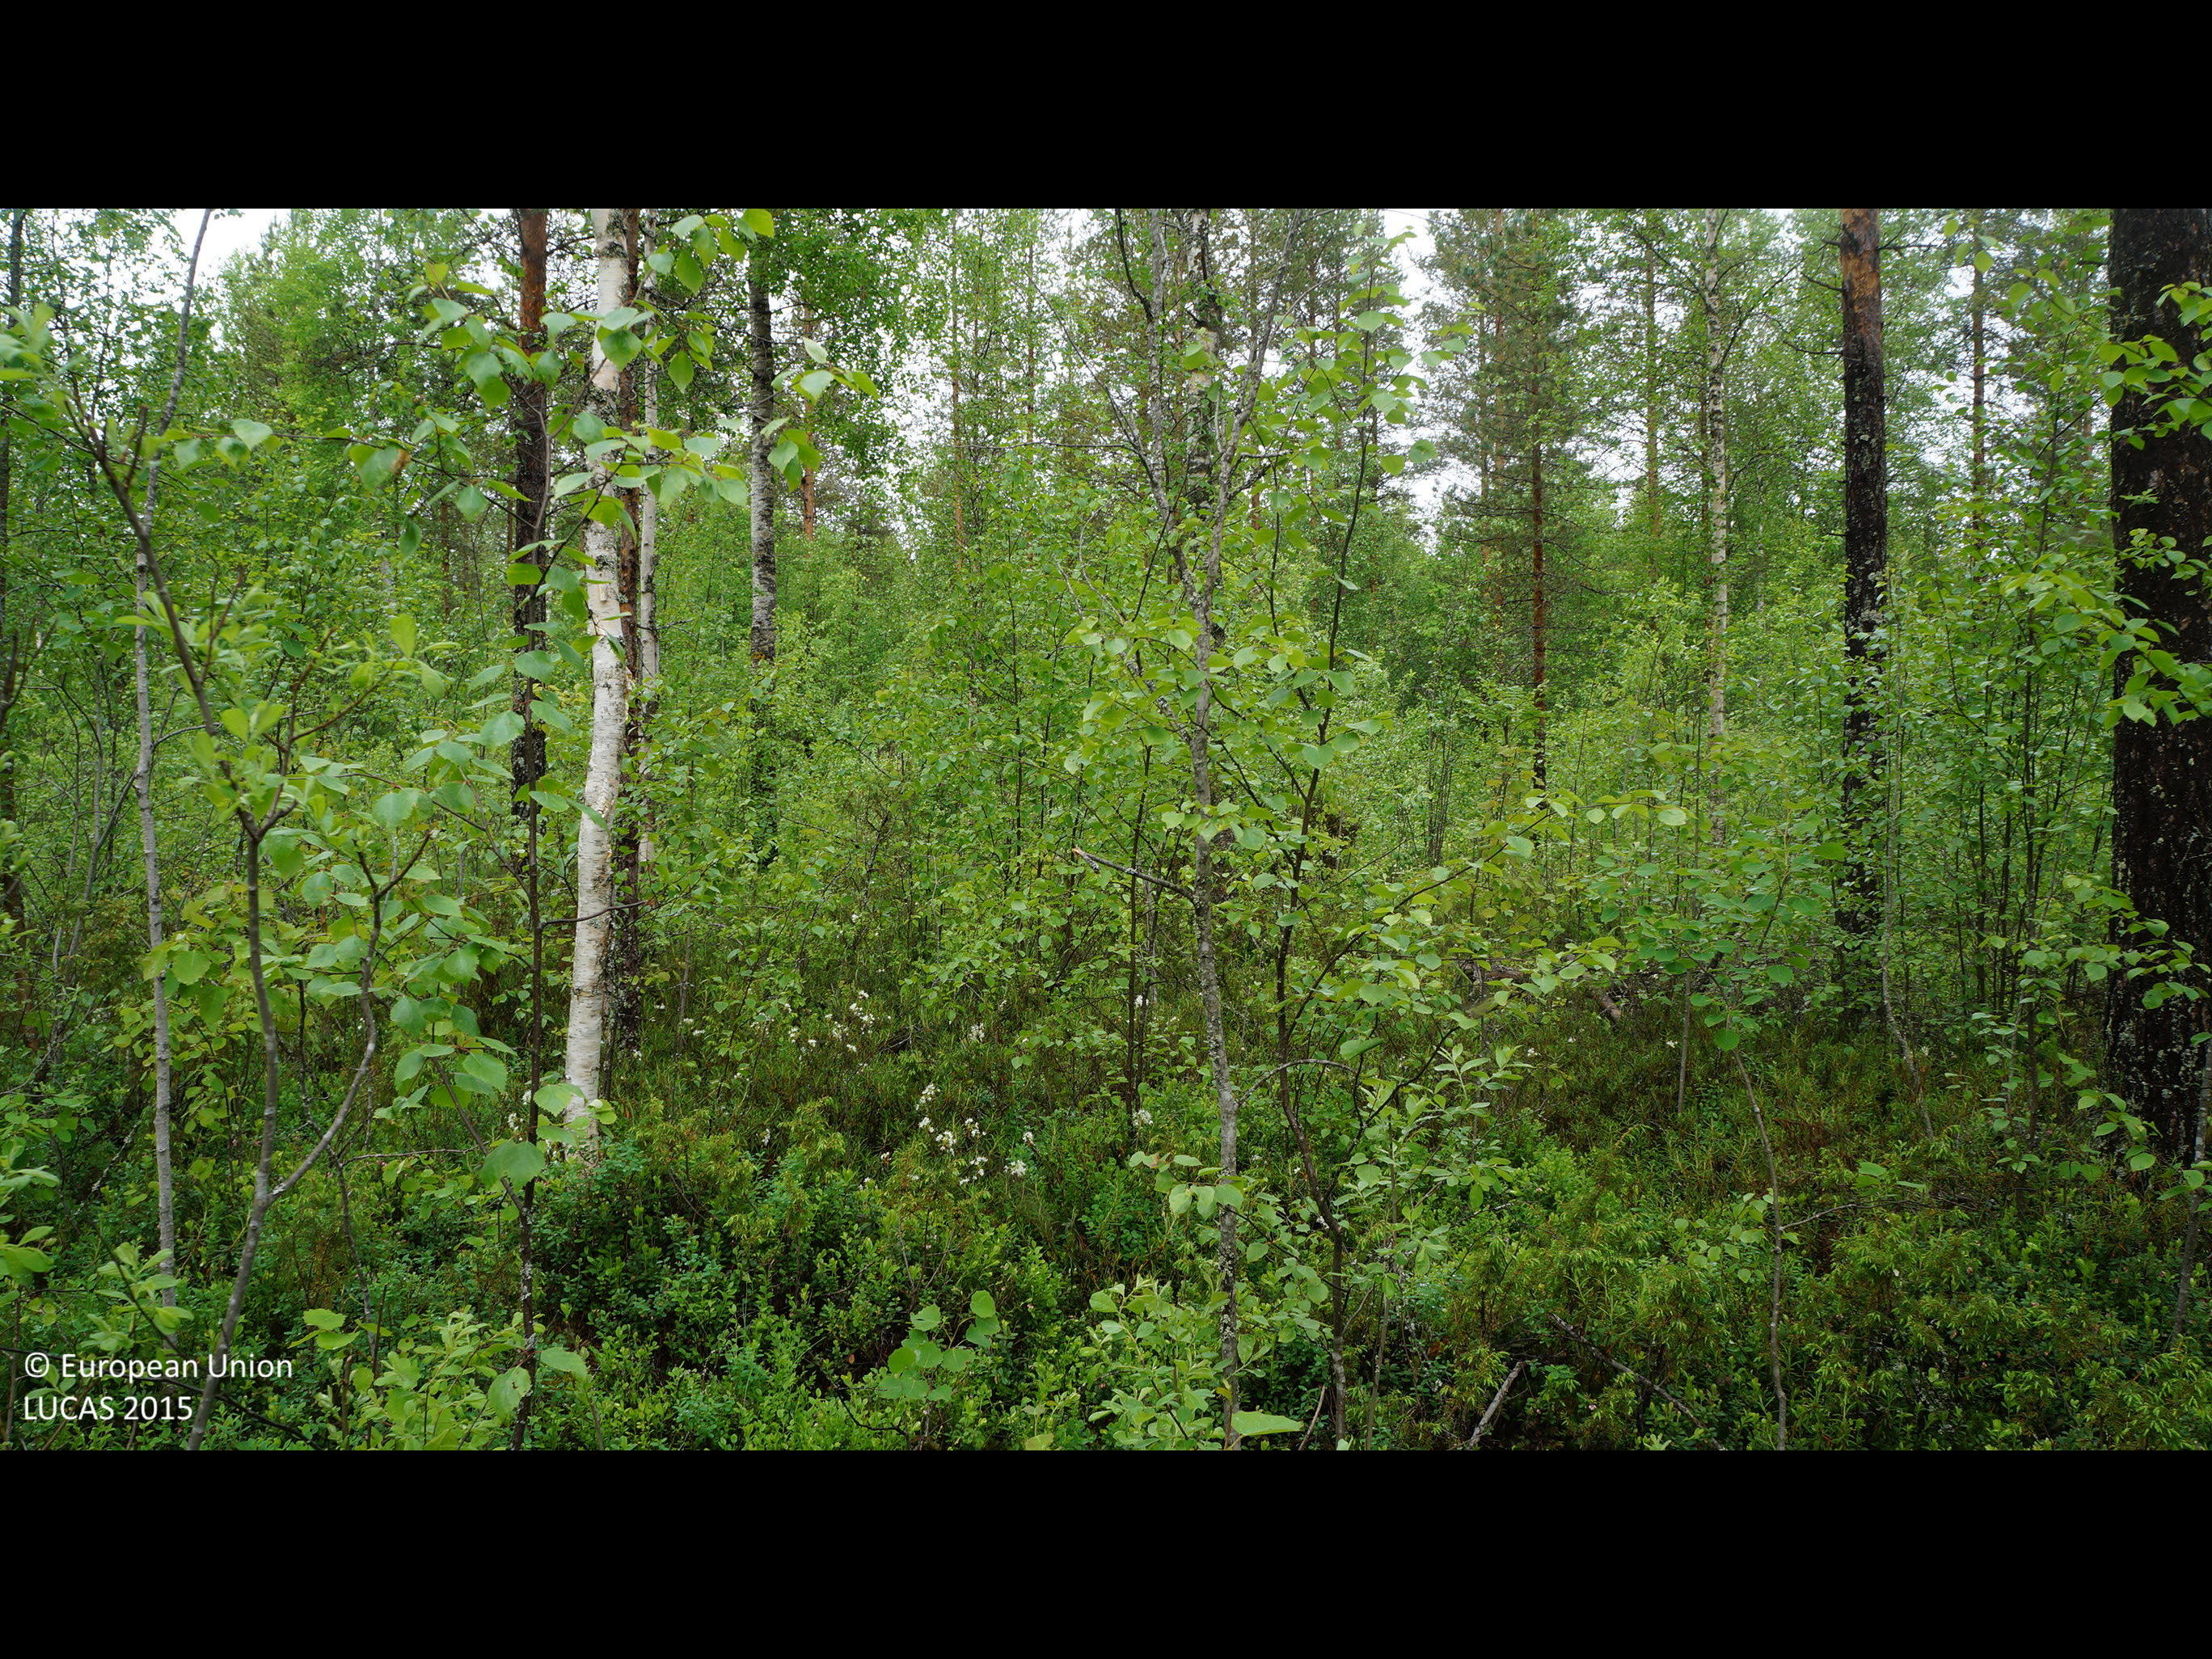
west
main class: Woodland
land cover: Pine dominated mixed woodland
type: boreal forest
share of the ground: 50 - 75 %
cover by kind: coniferous forest trees 35 %, shrubs 30 %, broadleaved forest trees 25 %, lichens and mosses 10 %
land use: Forestry
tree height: > 5 m
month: June
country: FI
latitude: 64.6827
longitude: 25.3206
